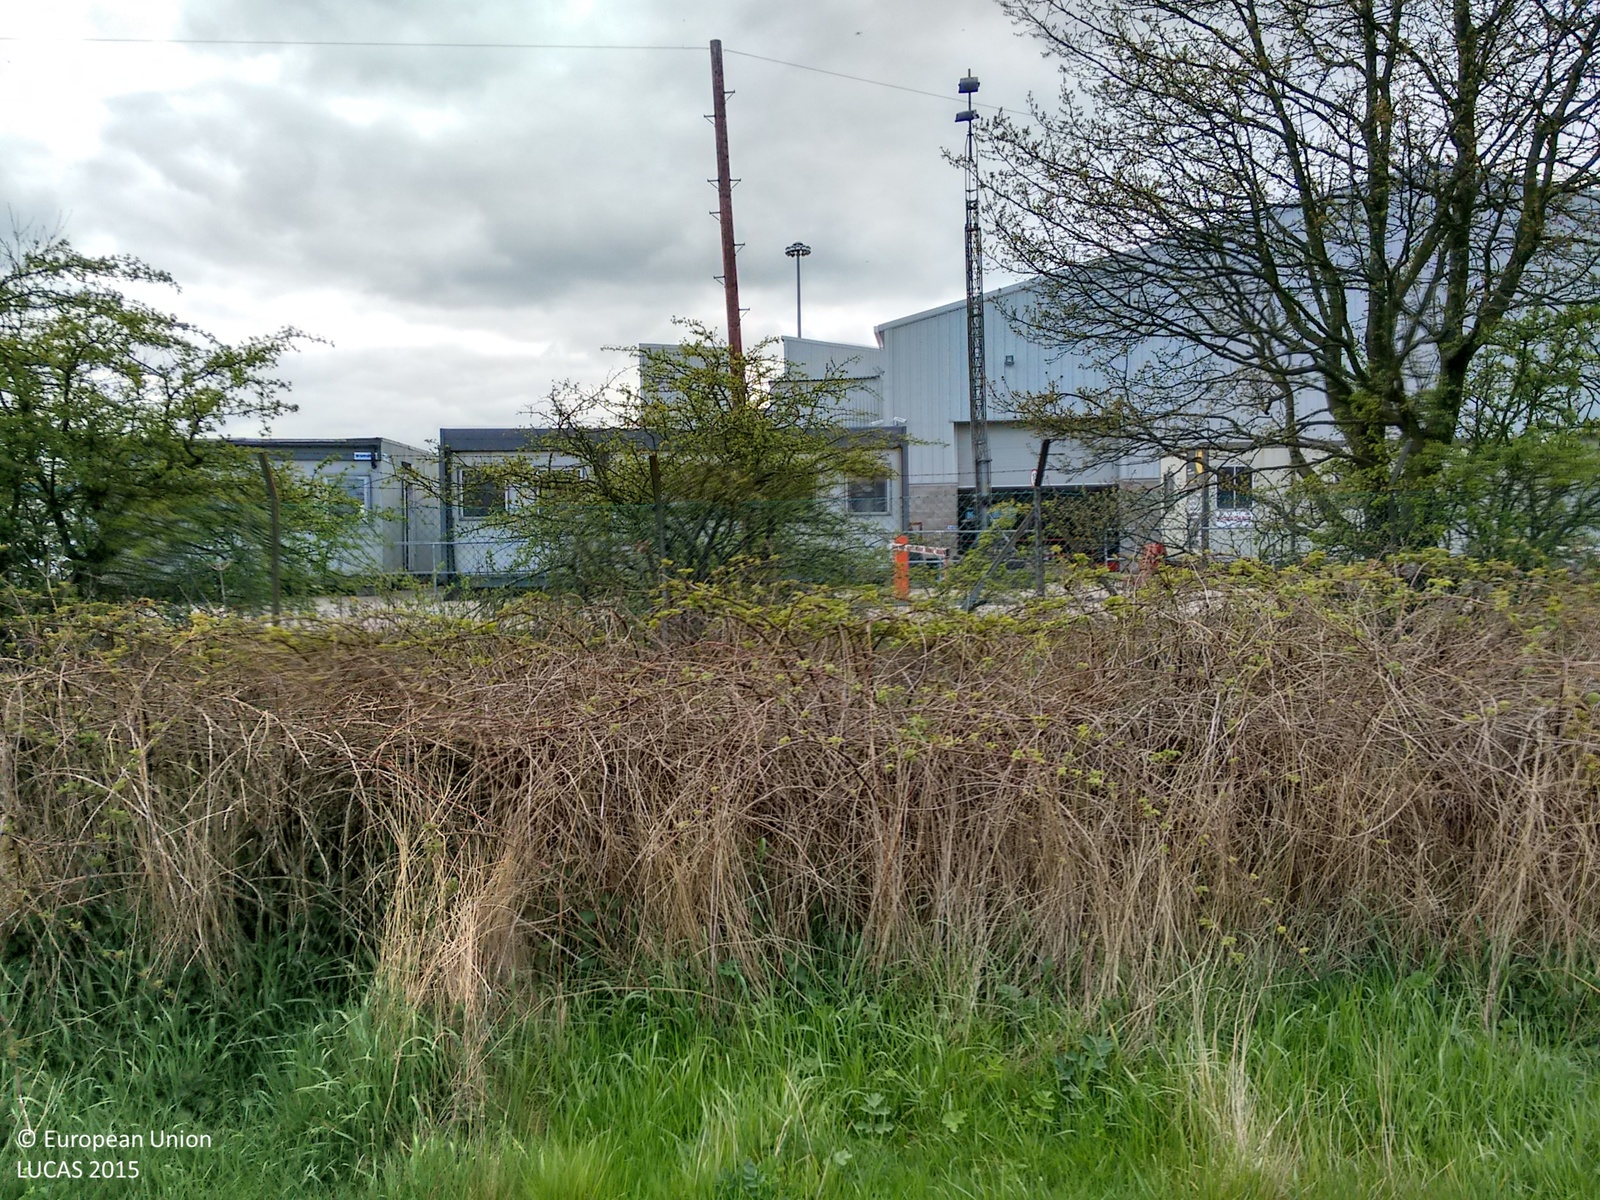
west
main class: Cropland
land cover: Rape and turnip rape
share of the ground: > 75 %
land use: Agriculture (excluding fallow land and kitchen gardens)
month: May
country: GB
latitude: 55.9379
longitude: -4.2284
